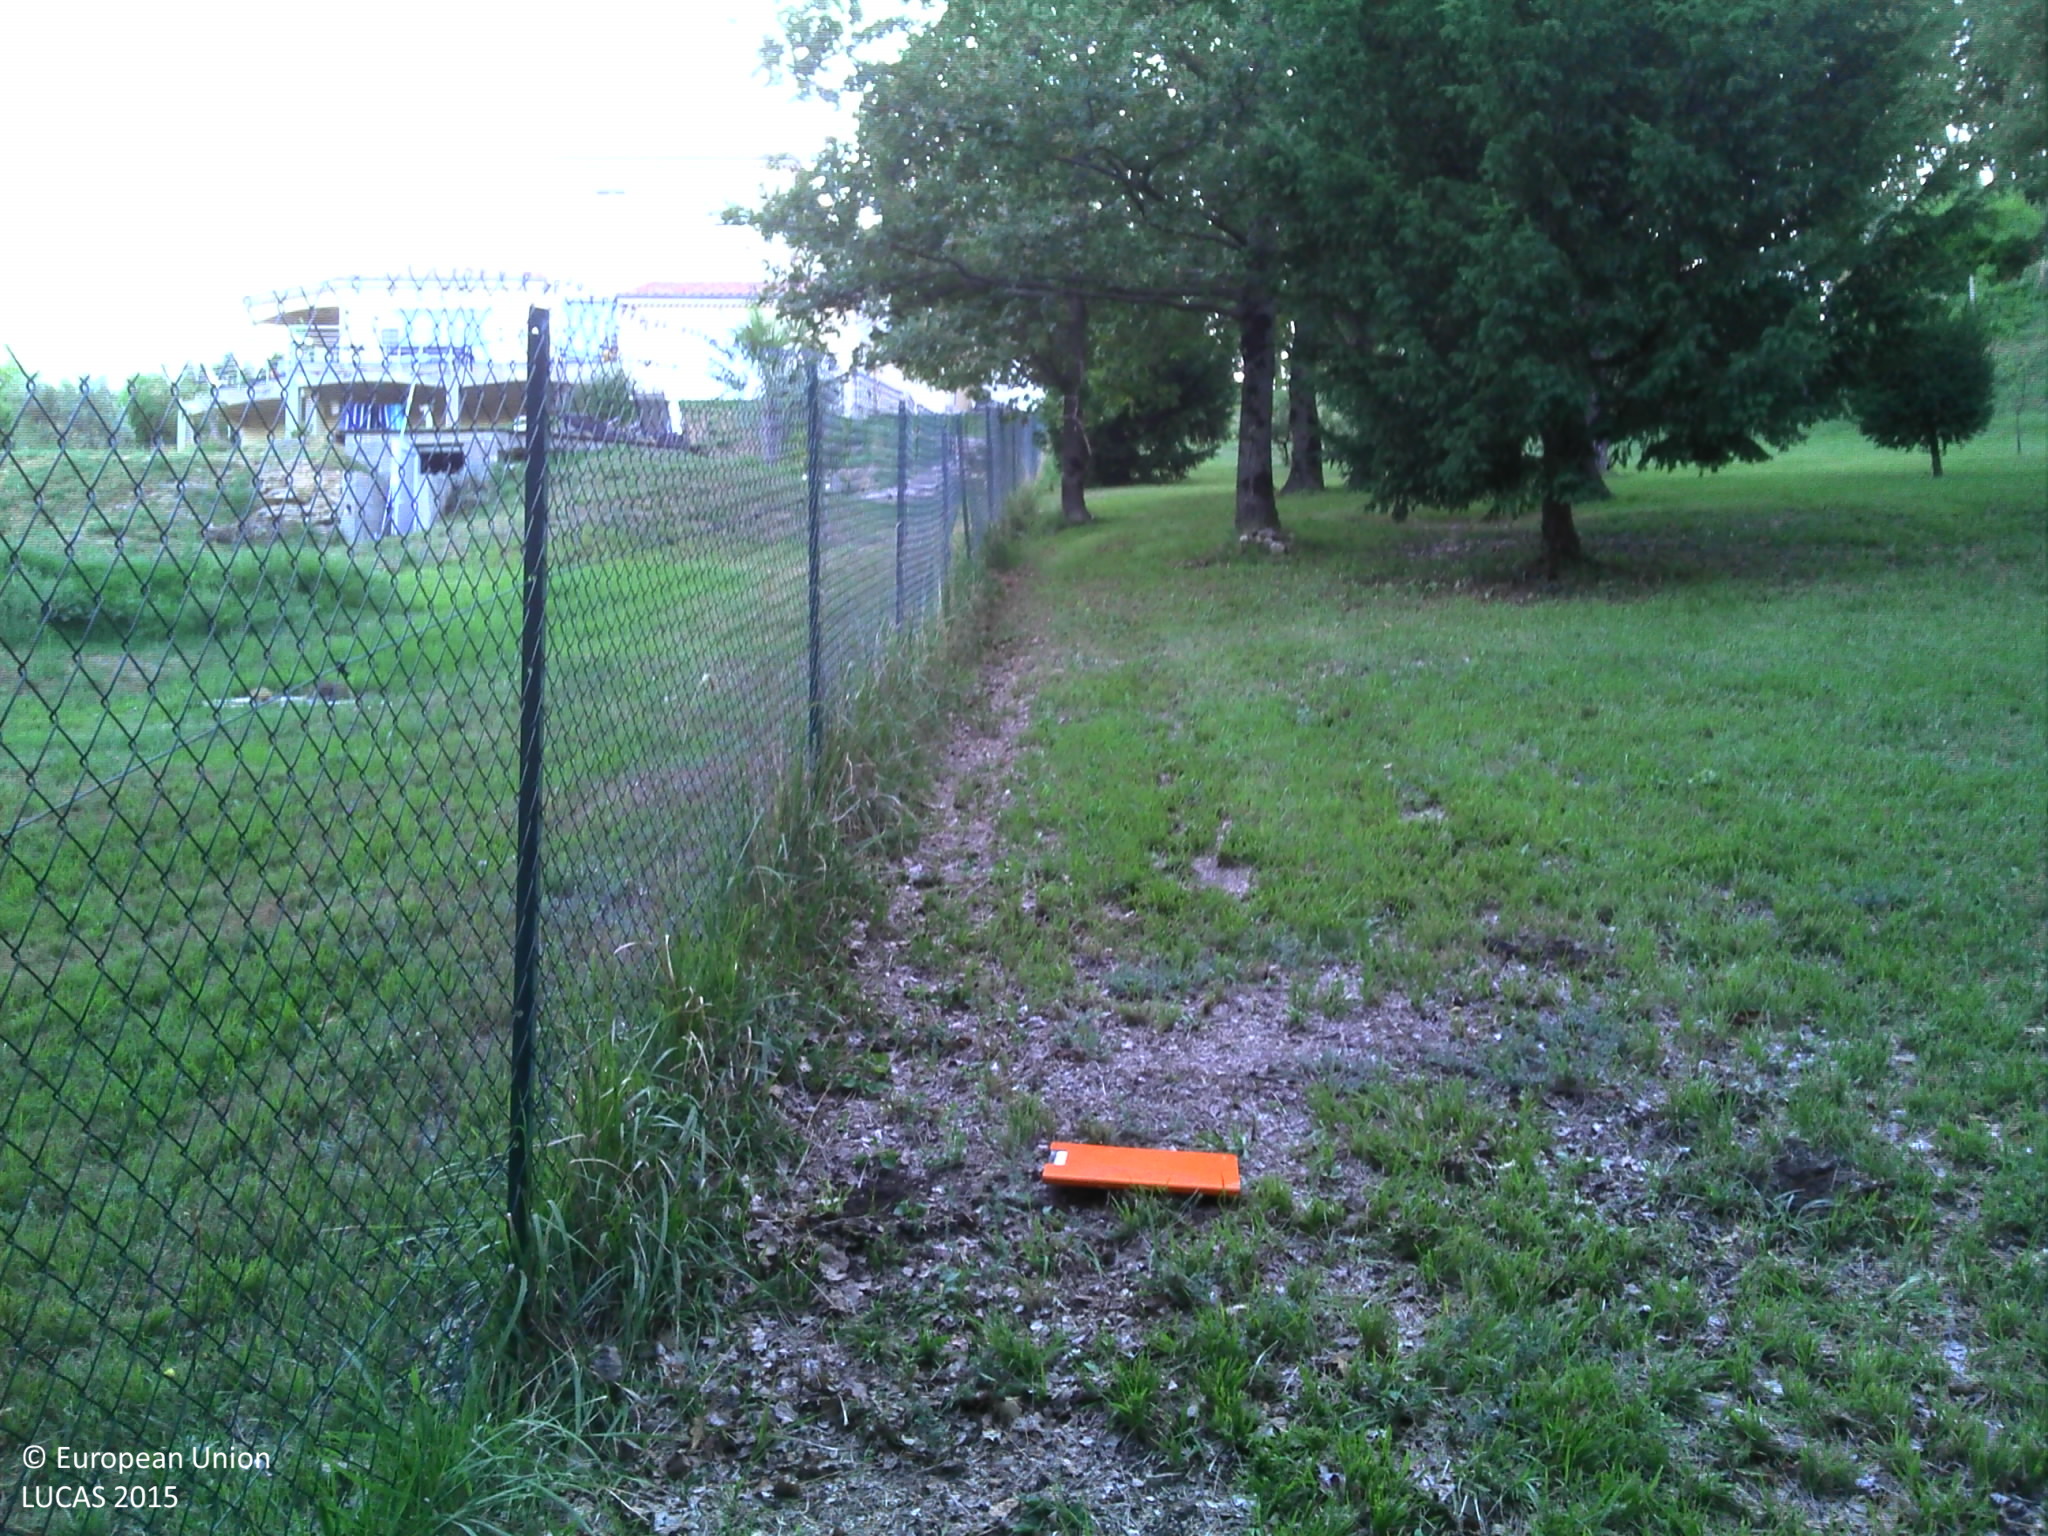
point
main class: Grassland
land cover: Grassland with sparse tree/shrub cover
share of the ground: > 75 %
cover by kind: herbaceous plants 90 %, broadleaved forest trees 5 %, shrubs 5 %
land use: Residential
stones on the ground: 25 - 50 %
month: June
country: FR
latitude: 44.7151
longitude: 4.9443
